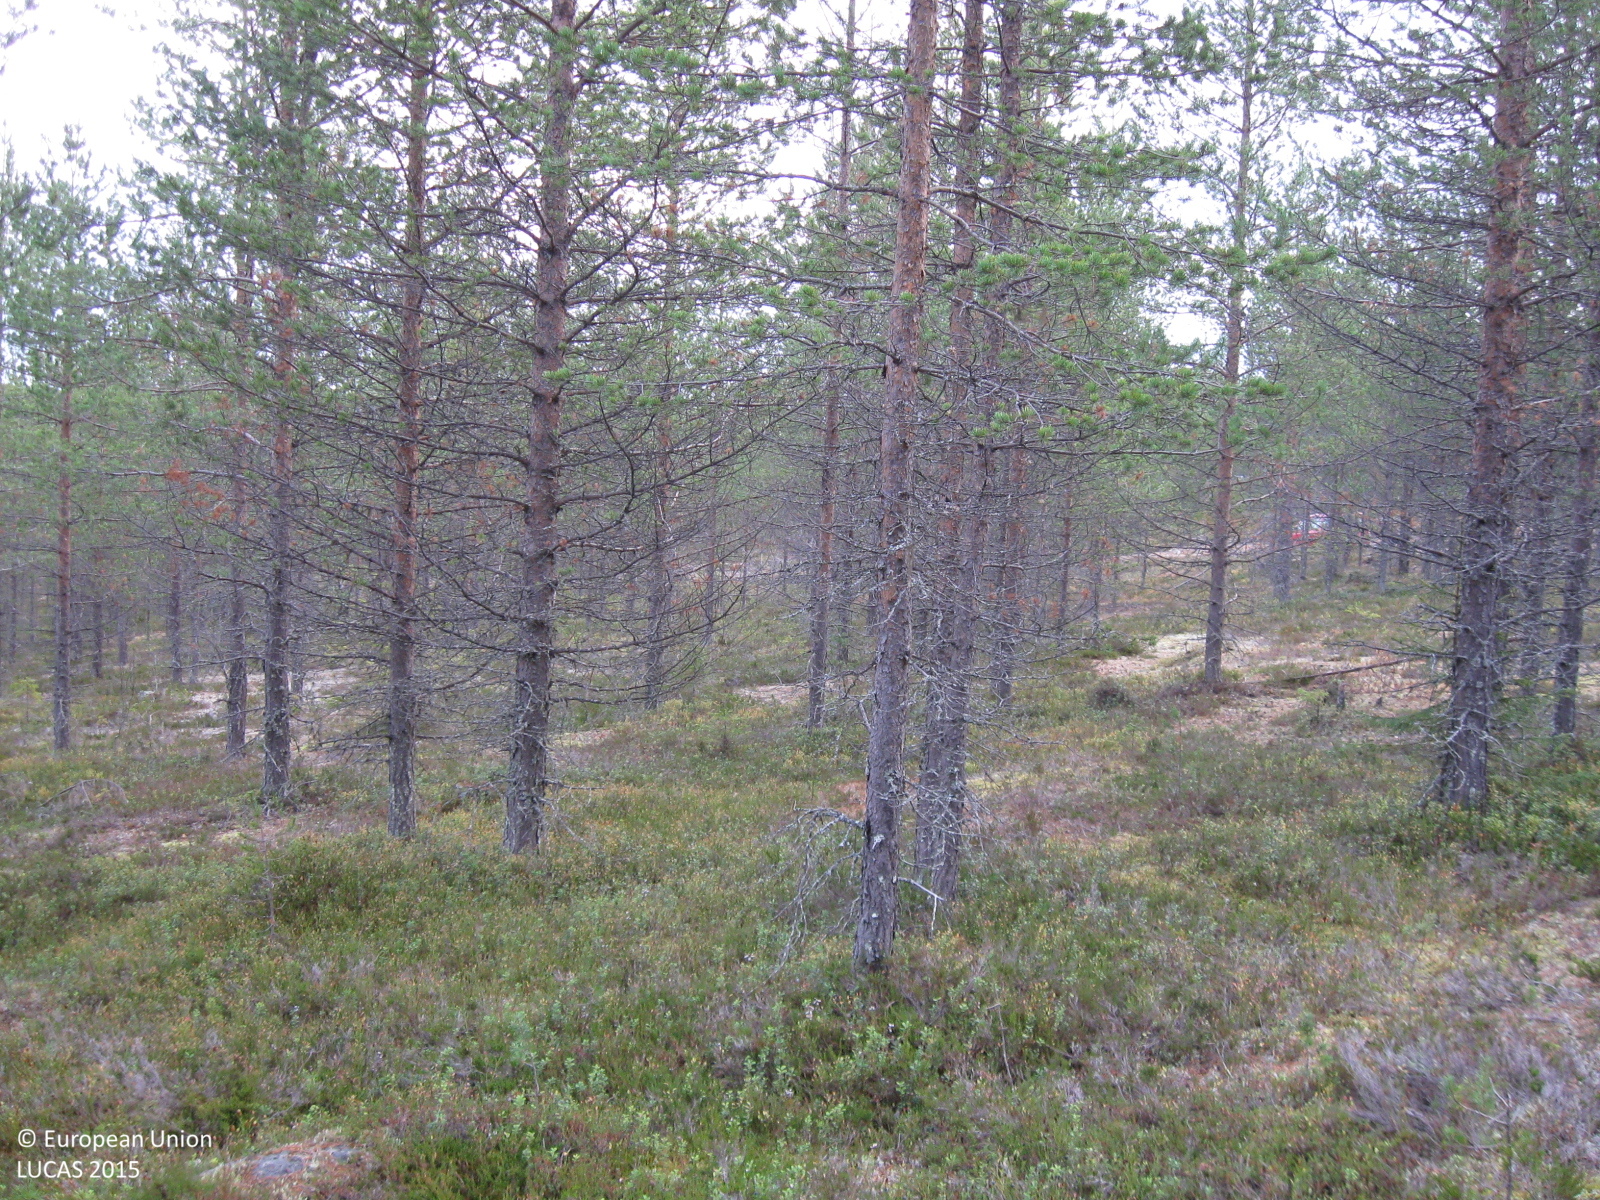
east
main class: Woodland
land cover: Pine dominated coniferous woodland
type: boreal forest
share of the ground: 50 - 75 %
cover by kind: coniferous forest trees 70 %, lichens and mosses 20 %, herbaceous plants 10 %
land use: Forestry
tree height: > 5 m
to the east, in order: Pine dominated coniferous woodland; Paved roads, cycling and walking lanes; Pine dominated coniferous woodland
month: October
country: SE
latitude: 66.0861
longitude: 22.2442
